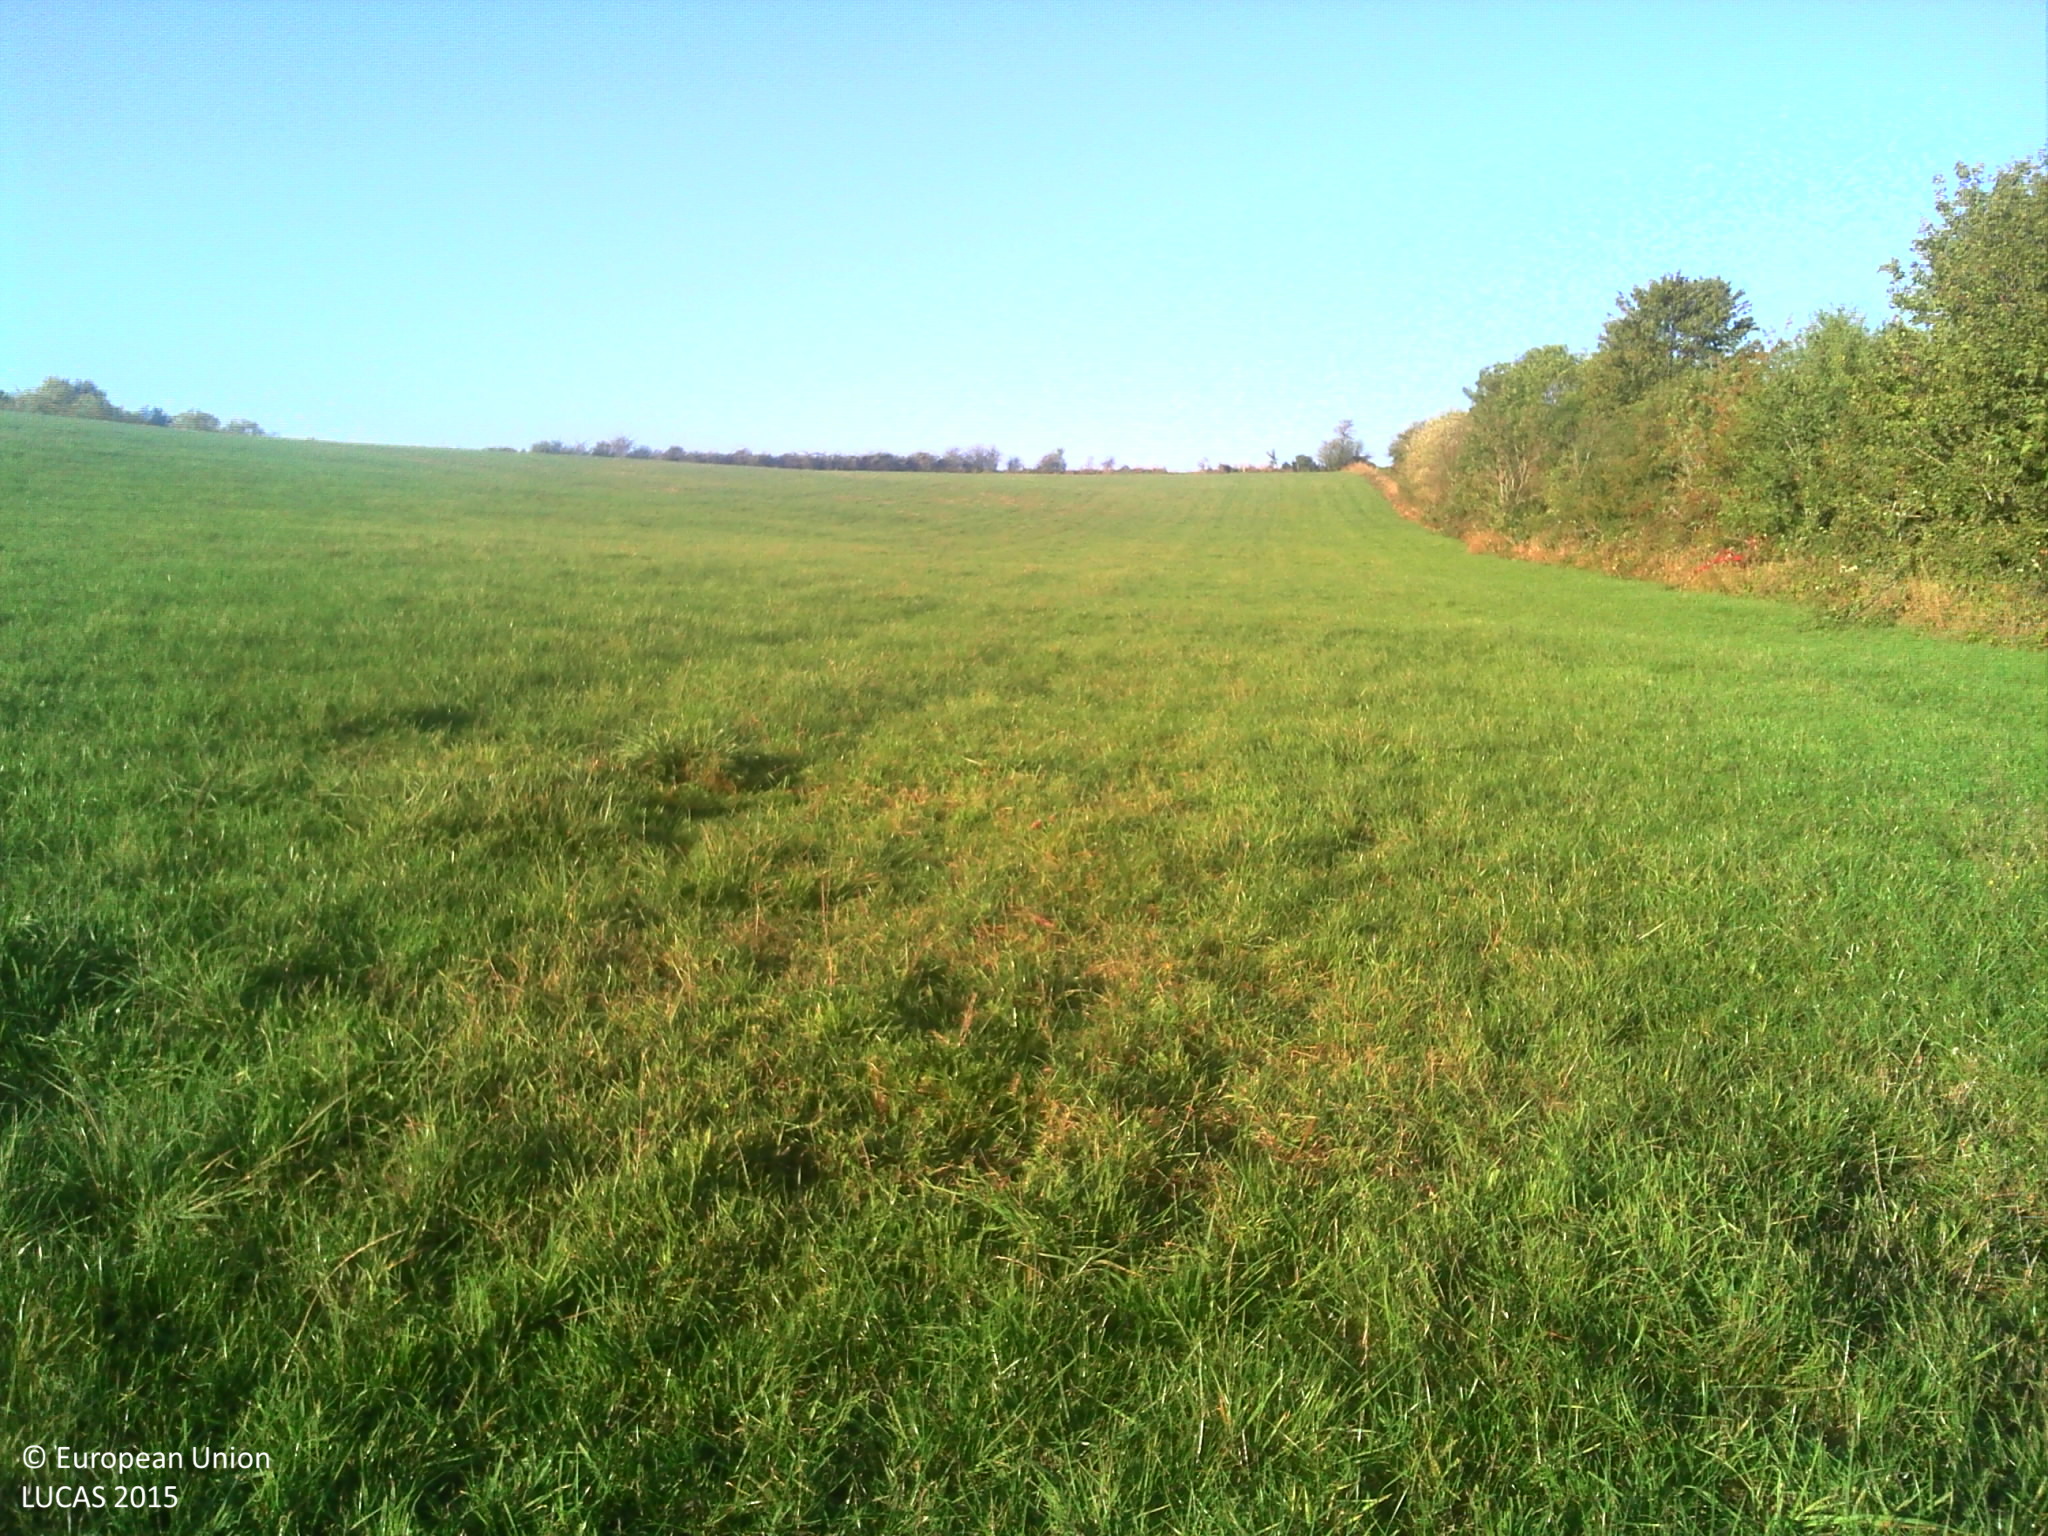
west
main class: Grassland
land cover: Grassland without tree/shrub cover
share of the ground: > 75 %
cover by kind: herbaceous plants 95 %, consolidated bare surface 5 %
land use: Agriculture (excluding fallow land and kitchen gardens)
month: October
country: FR
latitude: 48.4671
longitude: 6.2809
